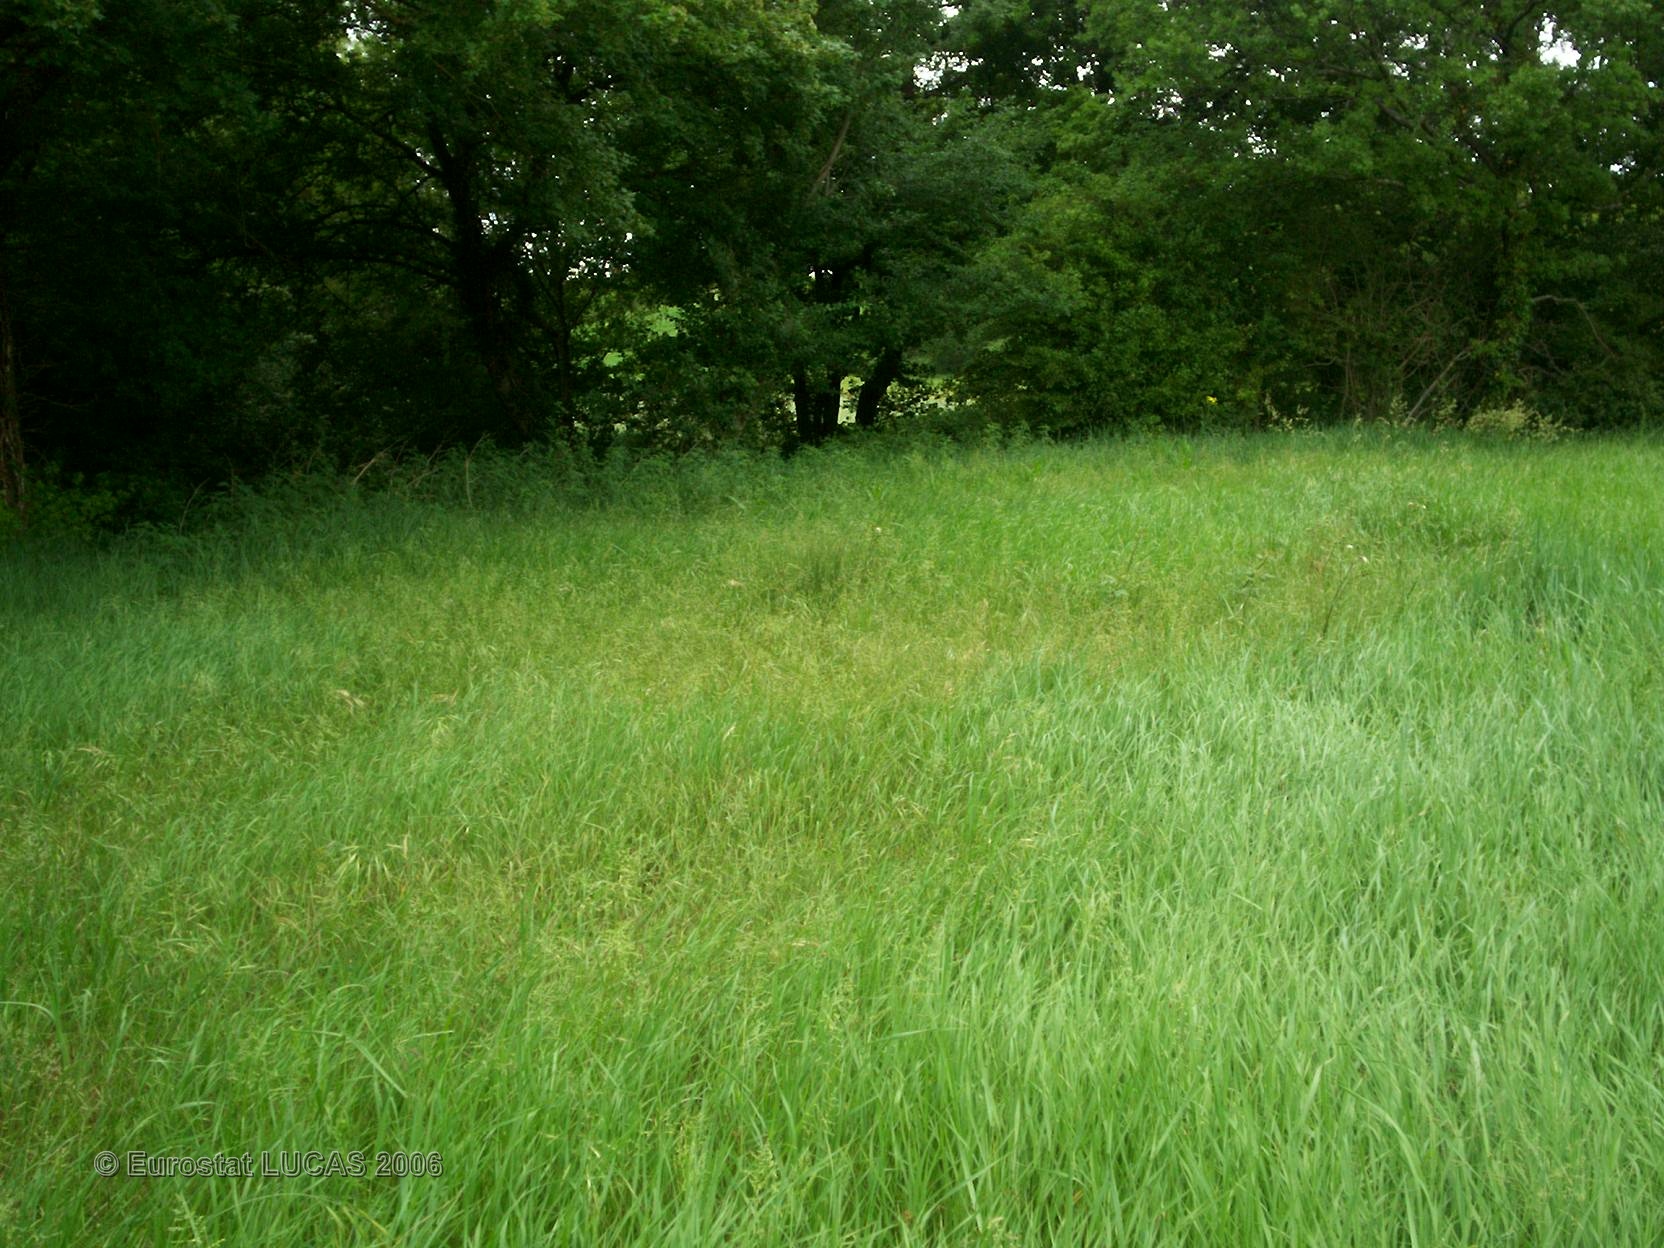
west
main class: Grassland
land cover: Grassland without tree/shrub cover
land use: Agriculture (excluding fallow land and kitchen gardens)
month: May
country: FR
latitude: 43.5282
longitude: 1.0552
